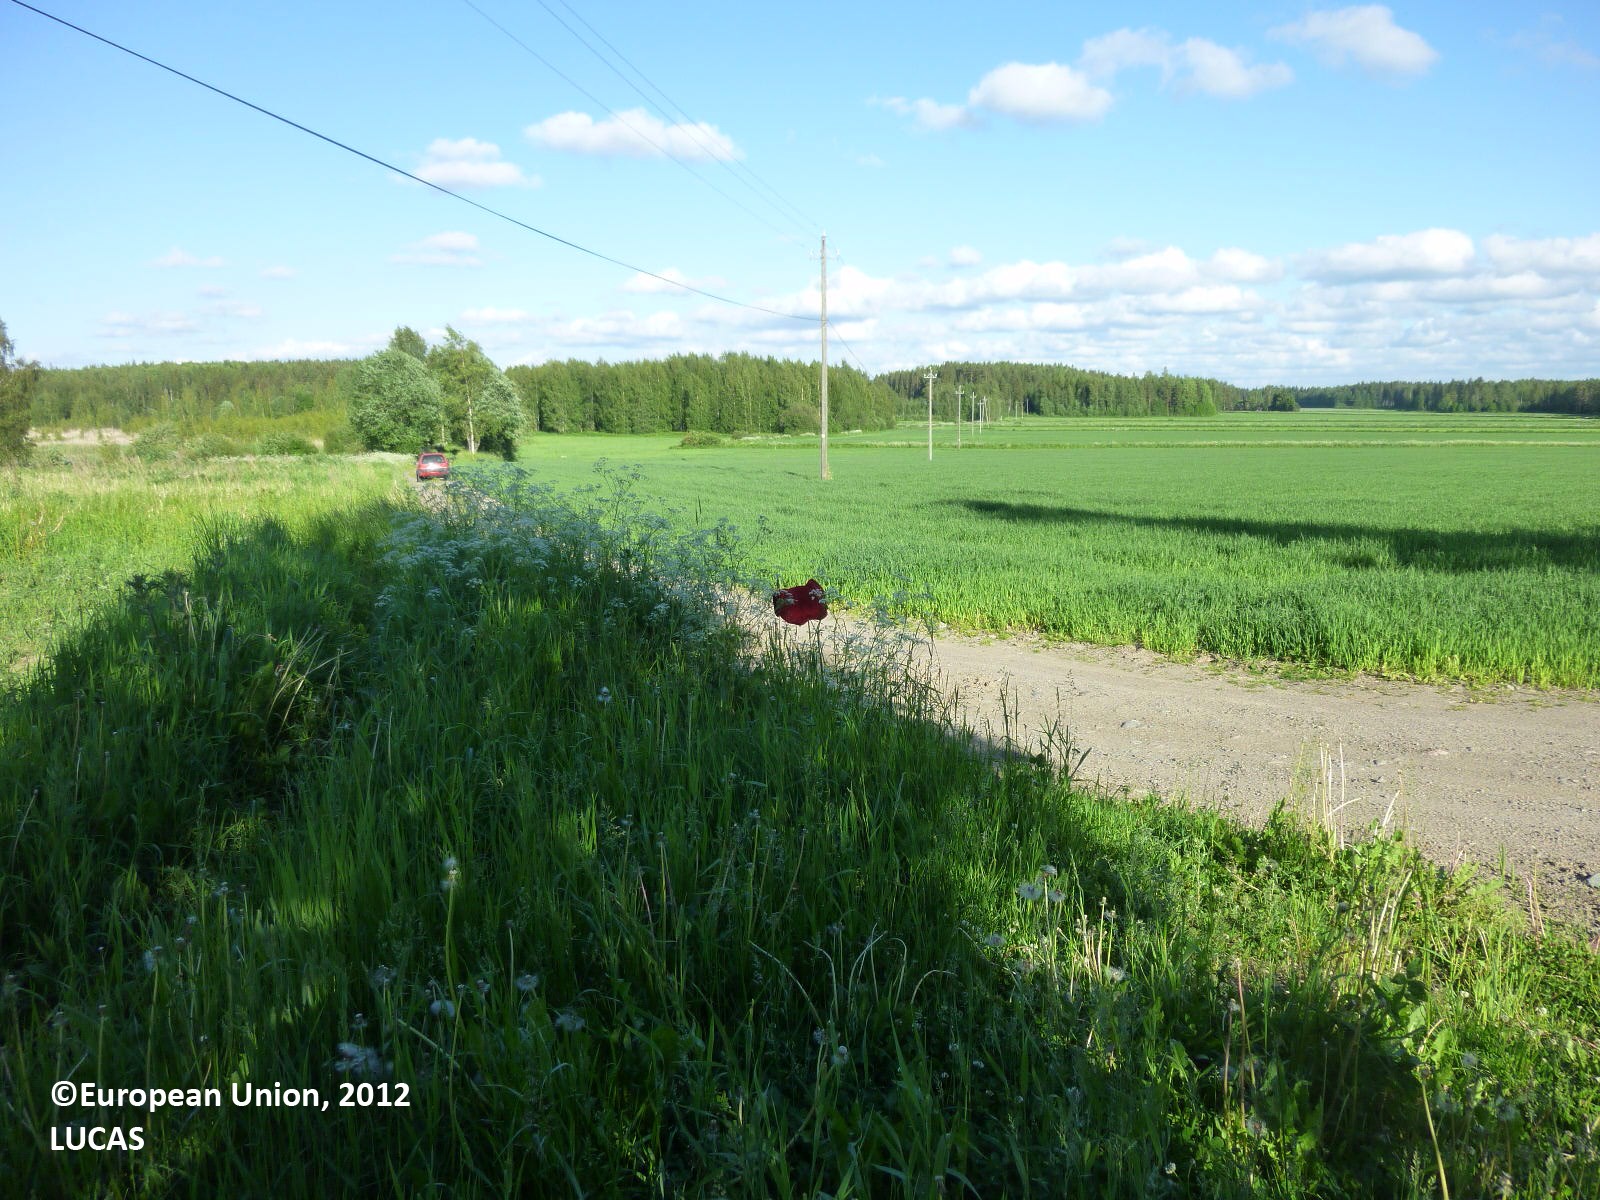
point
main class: Cropland
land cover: Potatoes
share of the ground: 25 - 50 %
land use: Kitchen garden
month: June
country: FI
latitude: 61.5011
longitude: 22.1006
